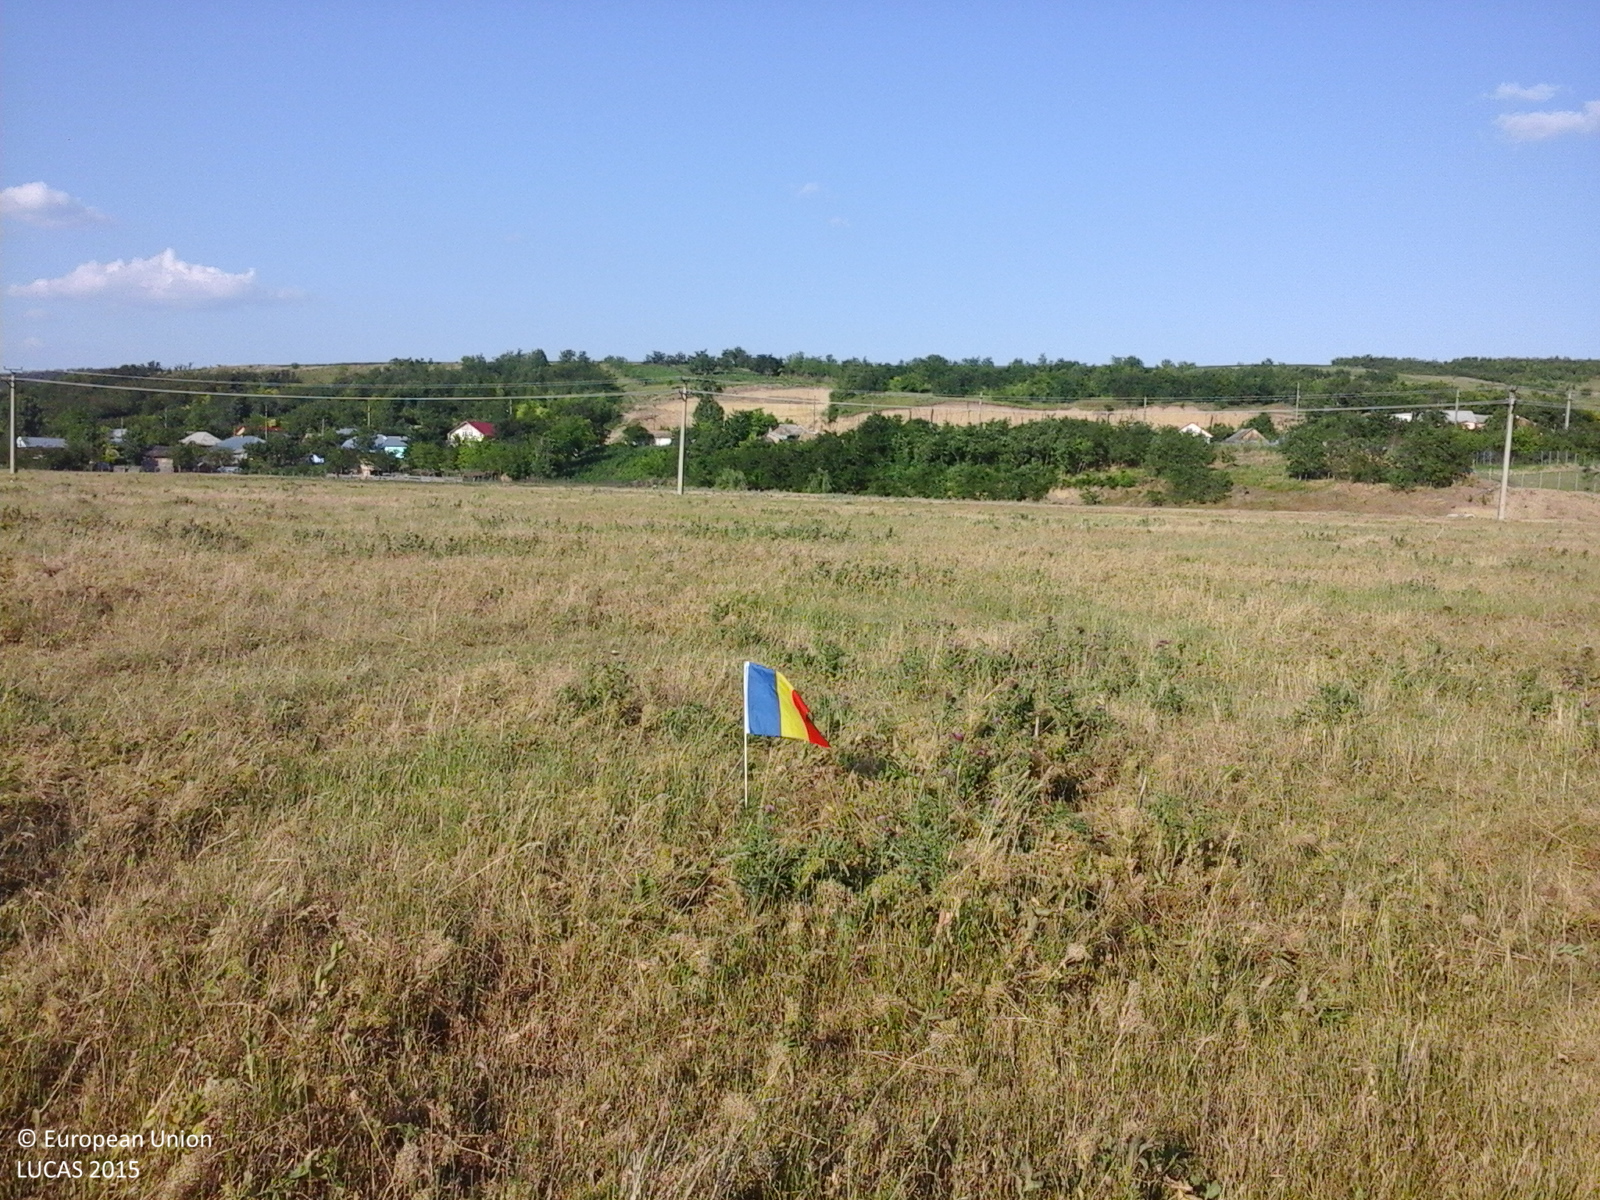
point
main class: Grassland
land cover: Grassland without tree/shrub cover
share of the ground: > 75 %
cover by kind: herbaceous plants 100 %
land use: Agriculture (excluding fallow land and kitchen gardens)
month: June
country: RO
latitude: 47.4036
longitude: 27.3526
